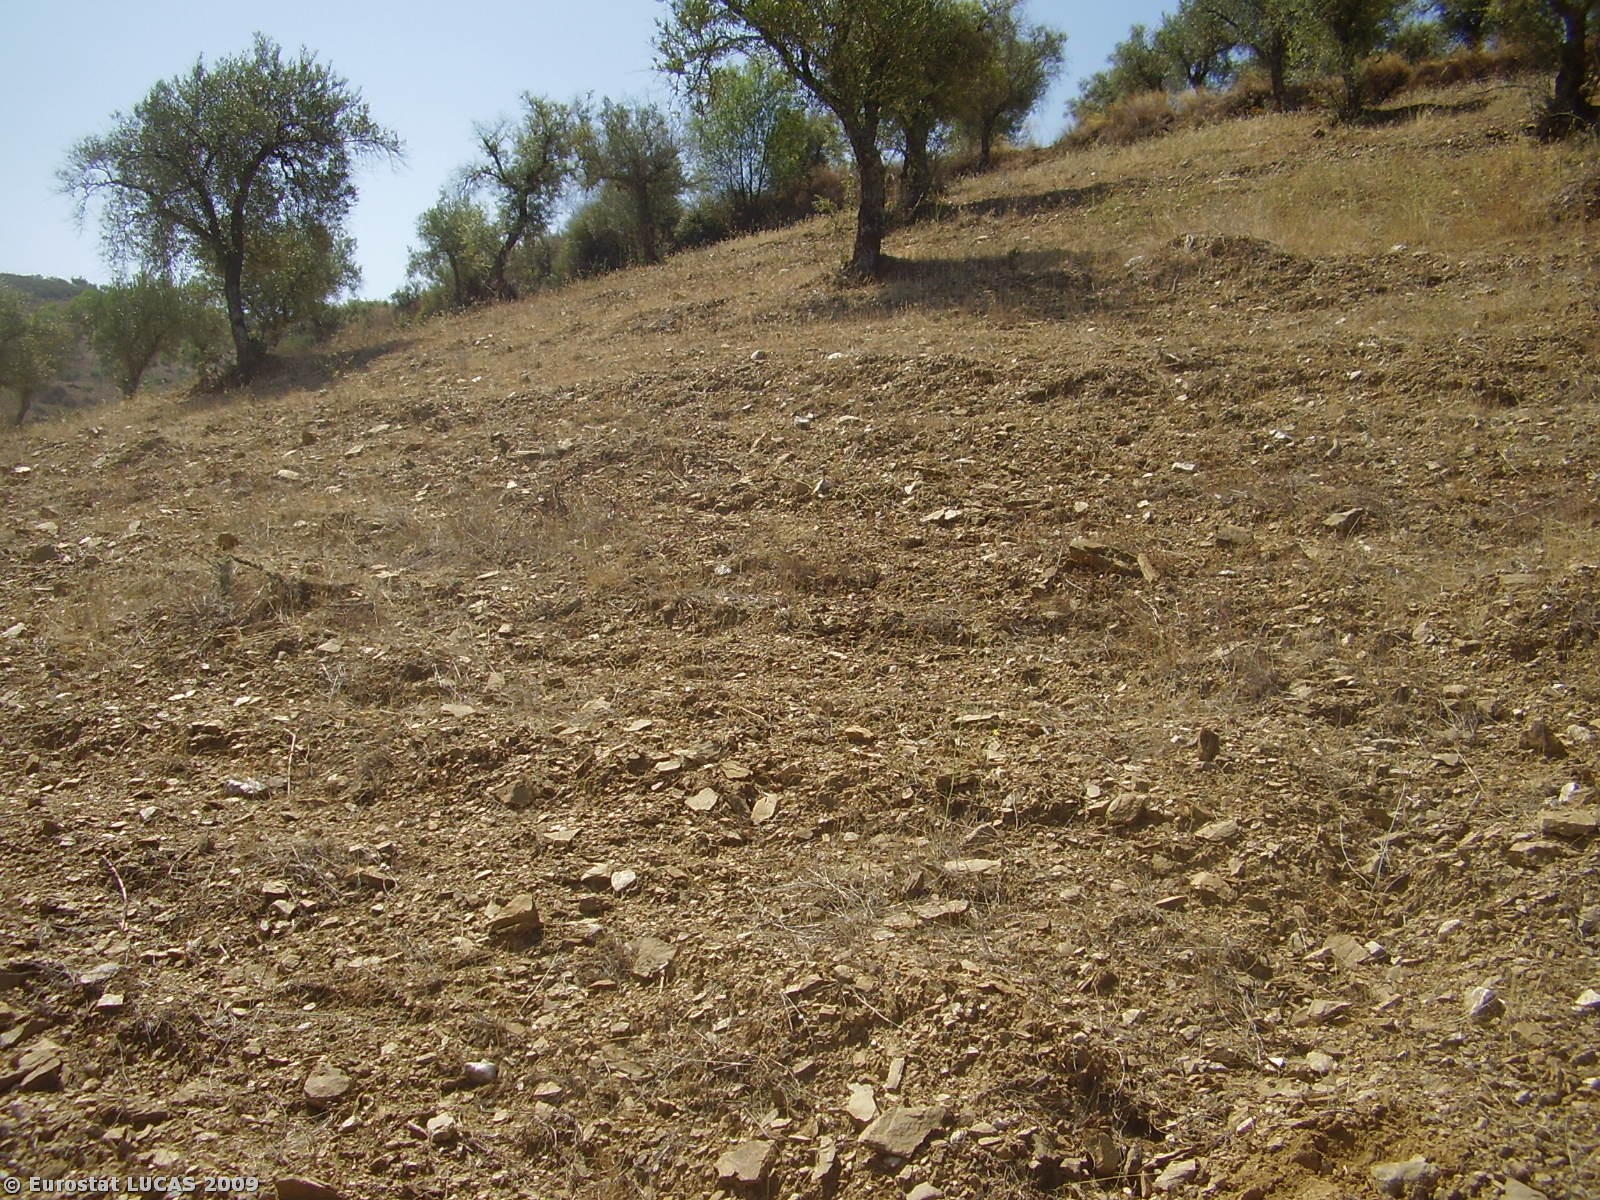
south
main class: Cropland
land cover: Olive groves
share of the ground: 10 - 25 %
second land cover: Spontaneously vegetated surfaces
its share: < 10 %
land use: Agriculture (excluding fallow land and kitchen gardens)
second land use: Fallow land
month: August
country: PT
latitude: 41.4366
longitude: -6.8285
